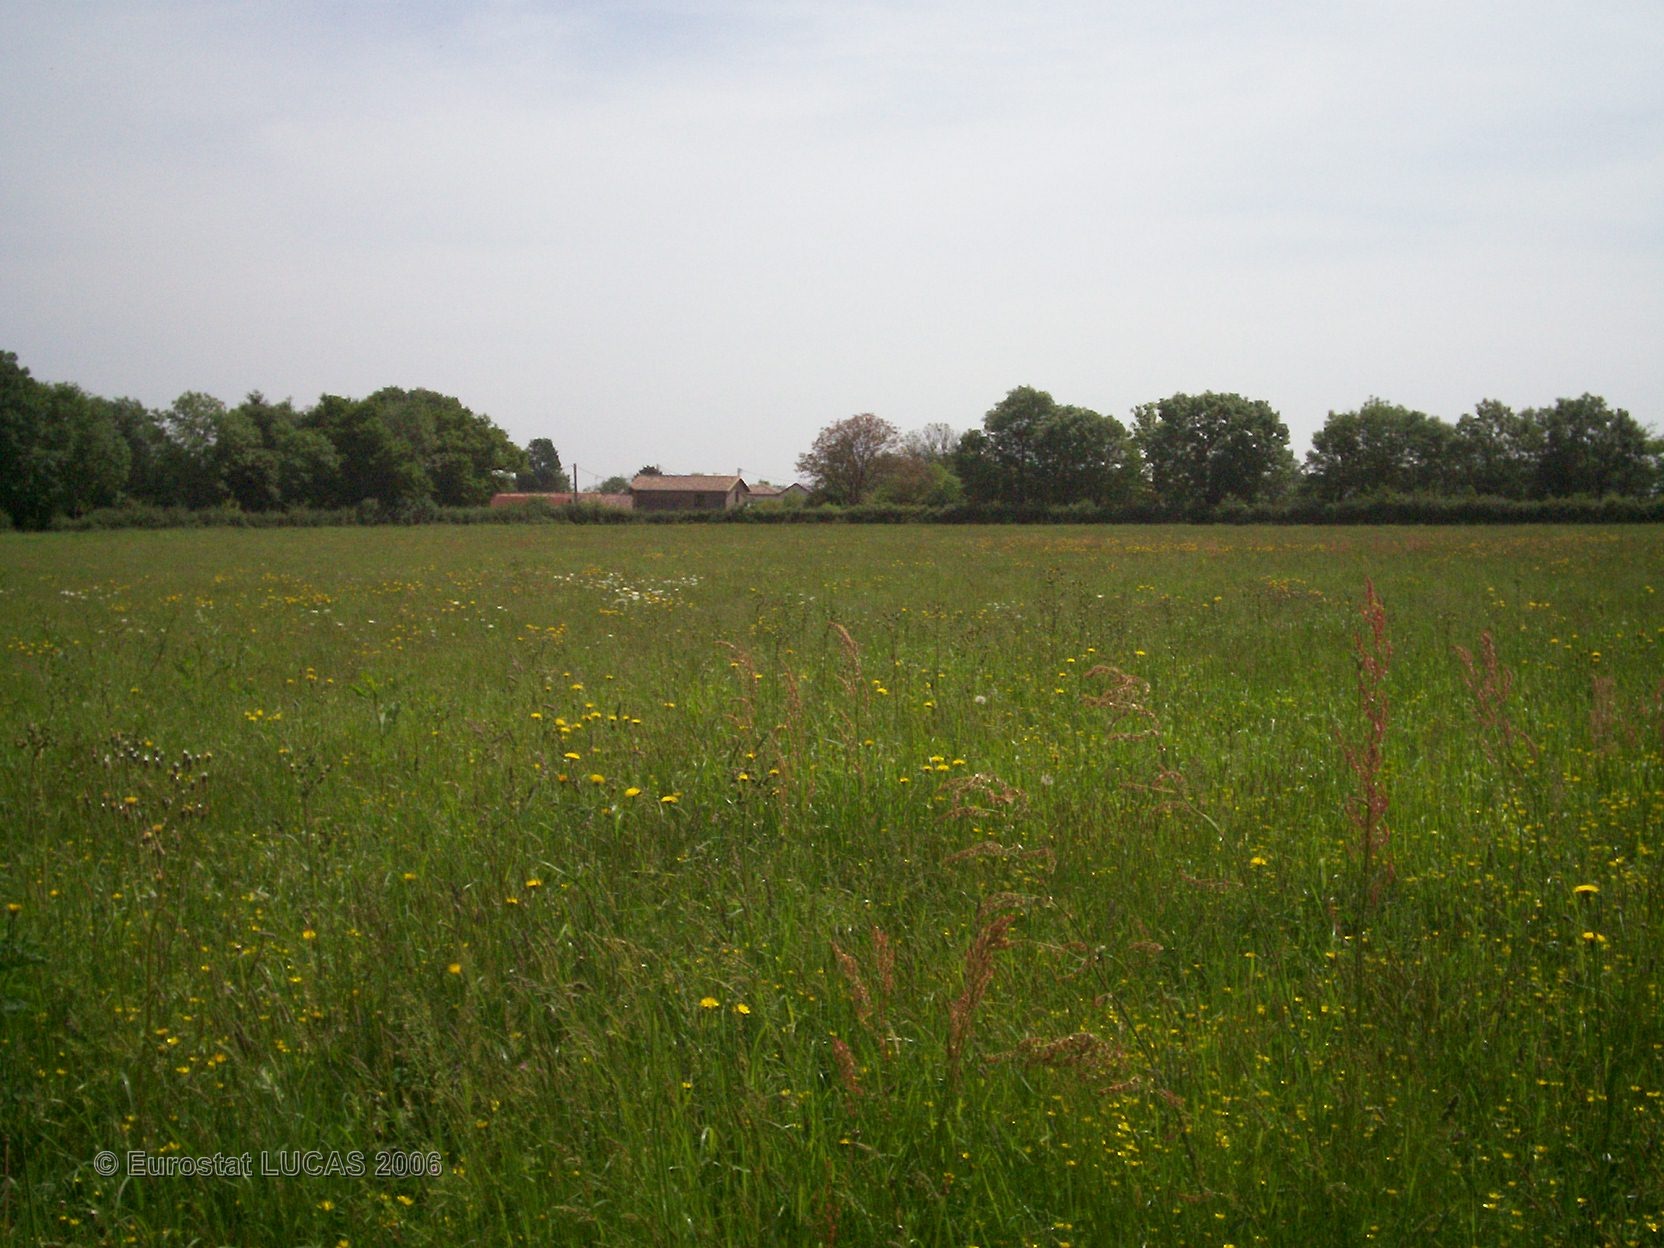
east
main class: Grassland
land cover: Grassland without tree/shrub cover
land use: Agriculture (excluding fallow land and kitchen gardens)
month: May
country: FR
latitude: 46.5232
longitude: -0.3100
